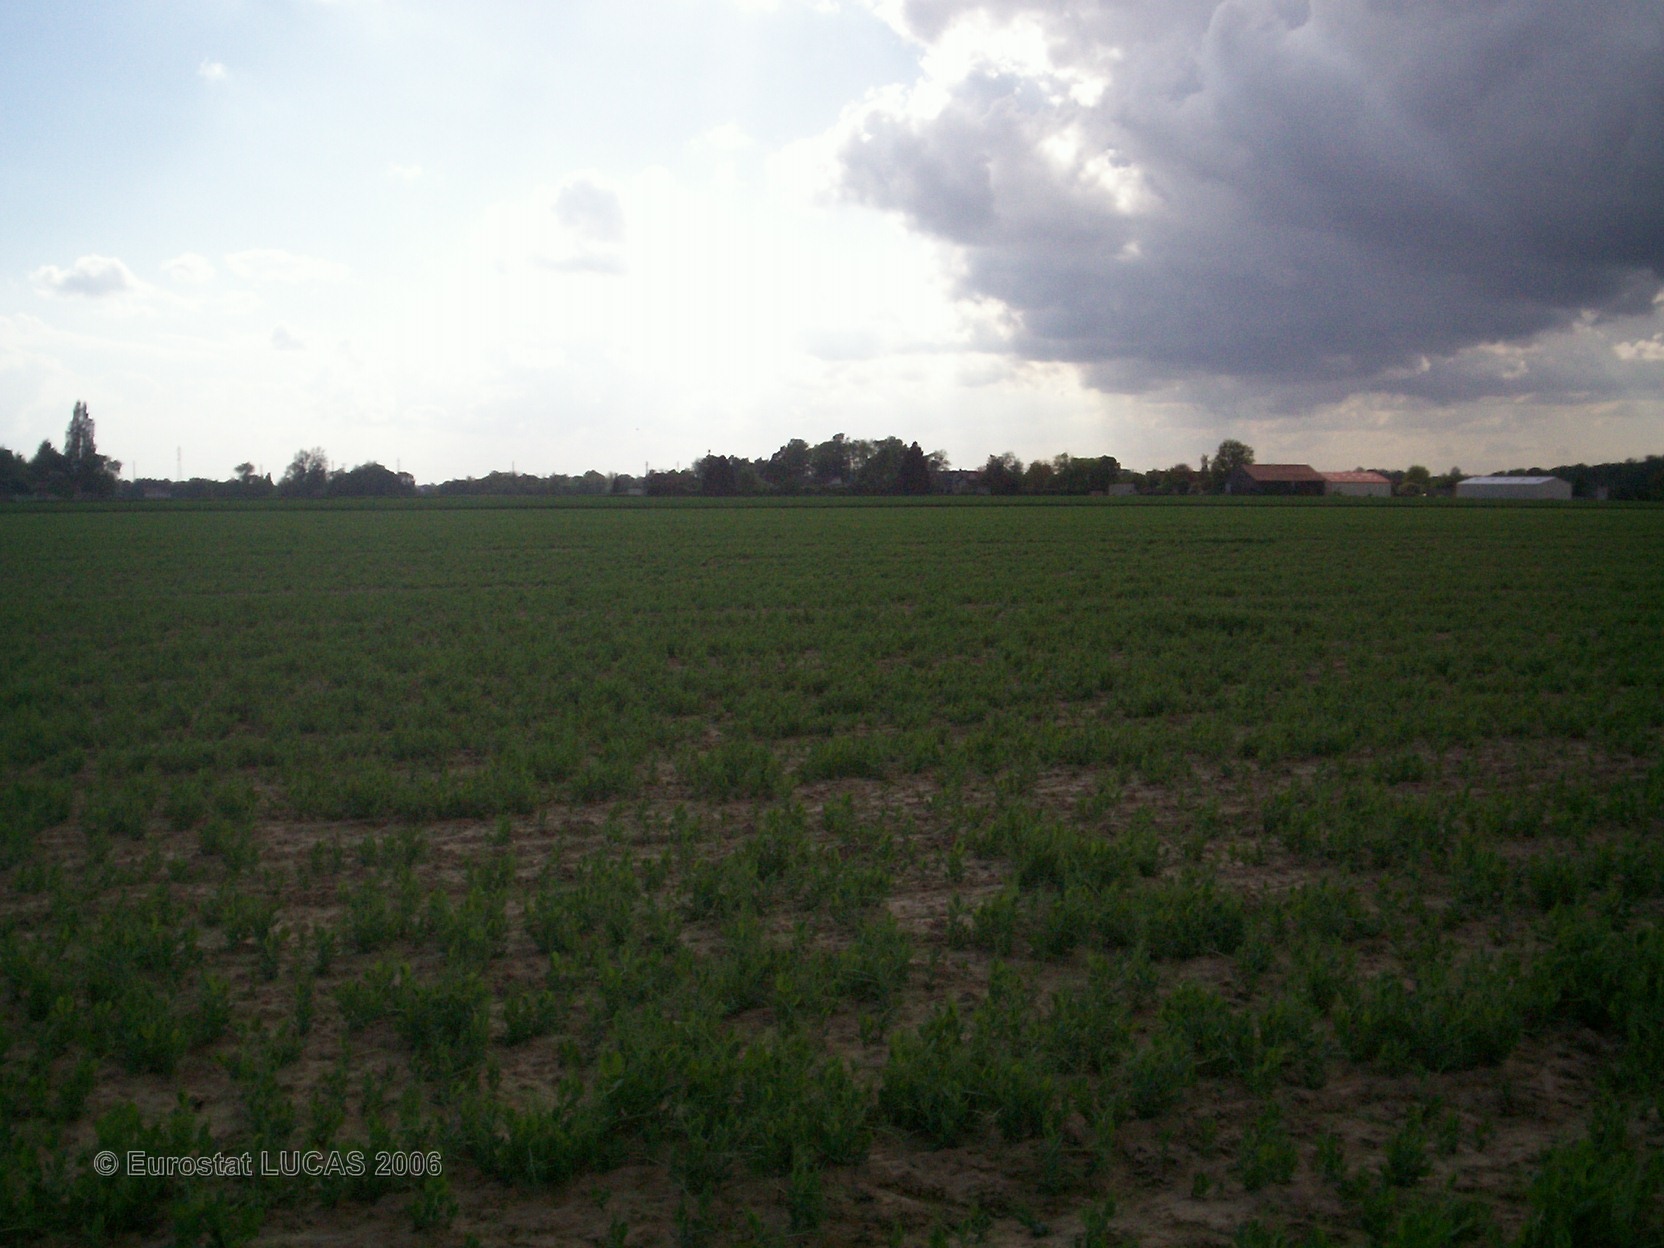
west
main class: Cropland
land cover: Dry pulses
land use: Agriculture (excluding fallow land and kitchen gardens)
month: May
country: FR
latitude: 48.7464
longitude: 2.7962
